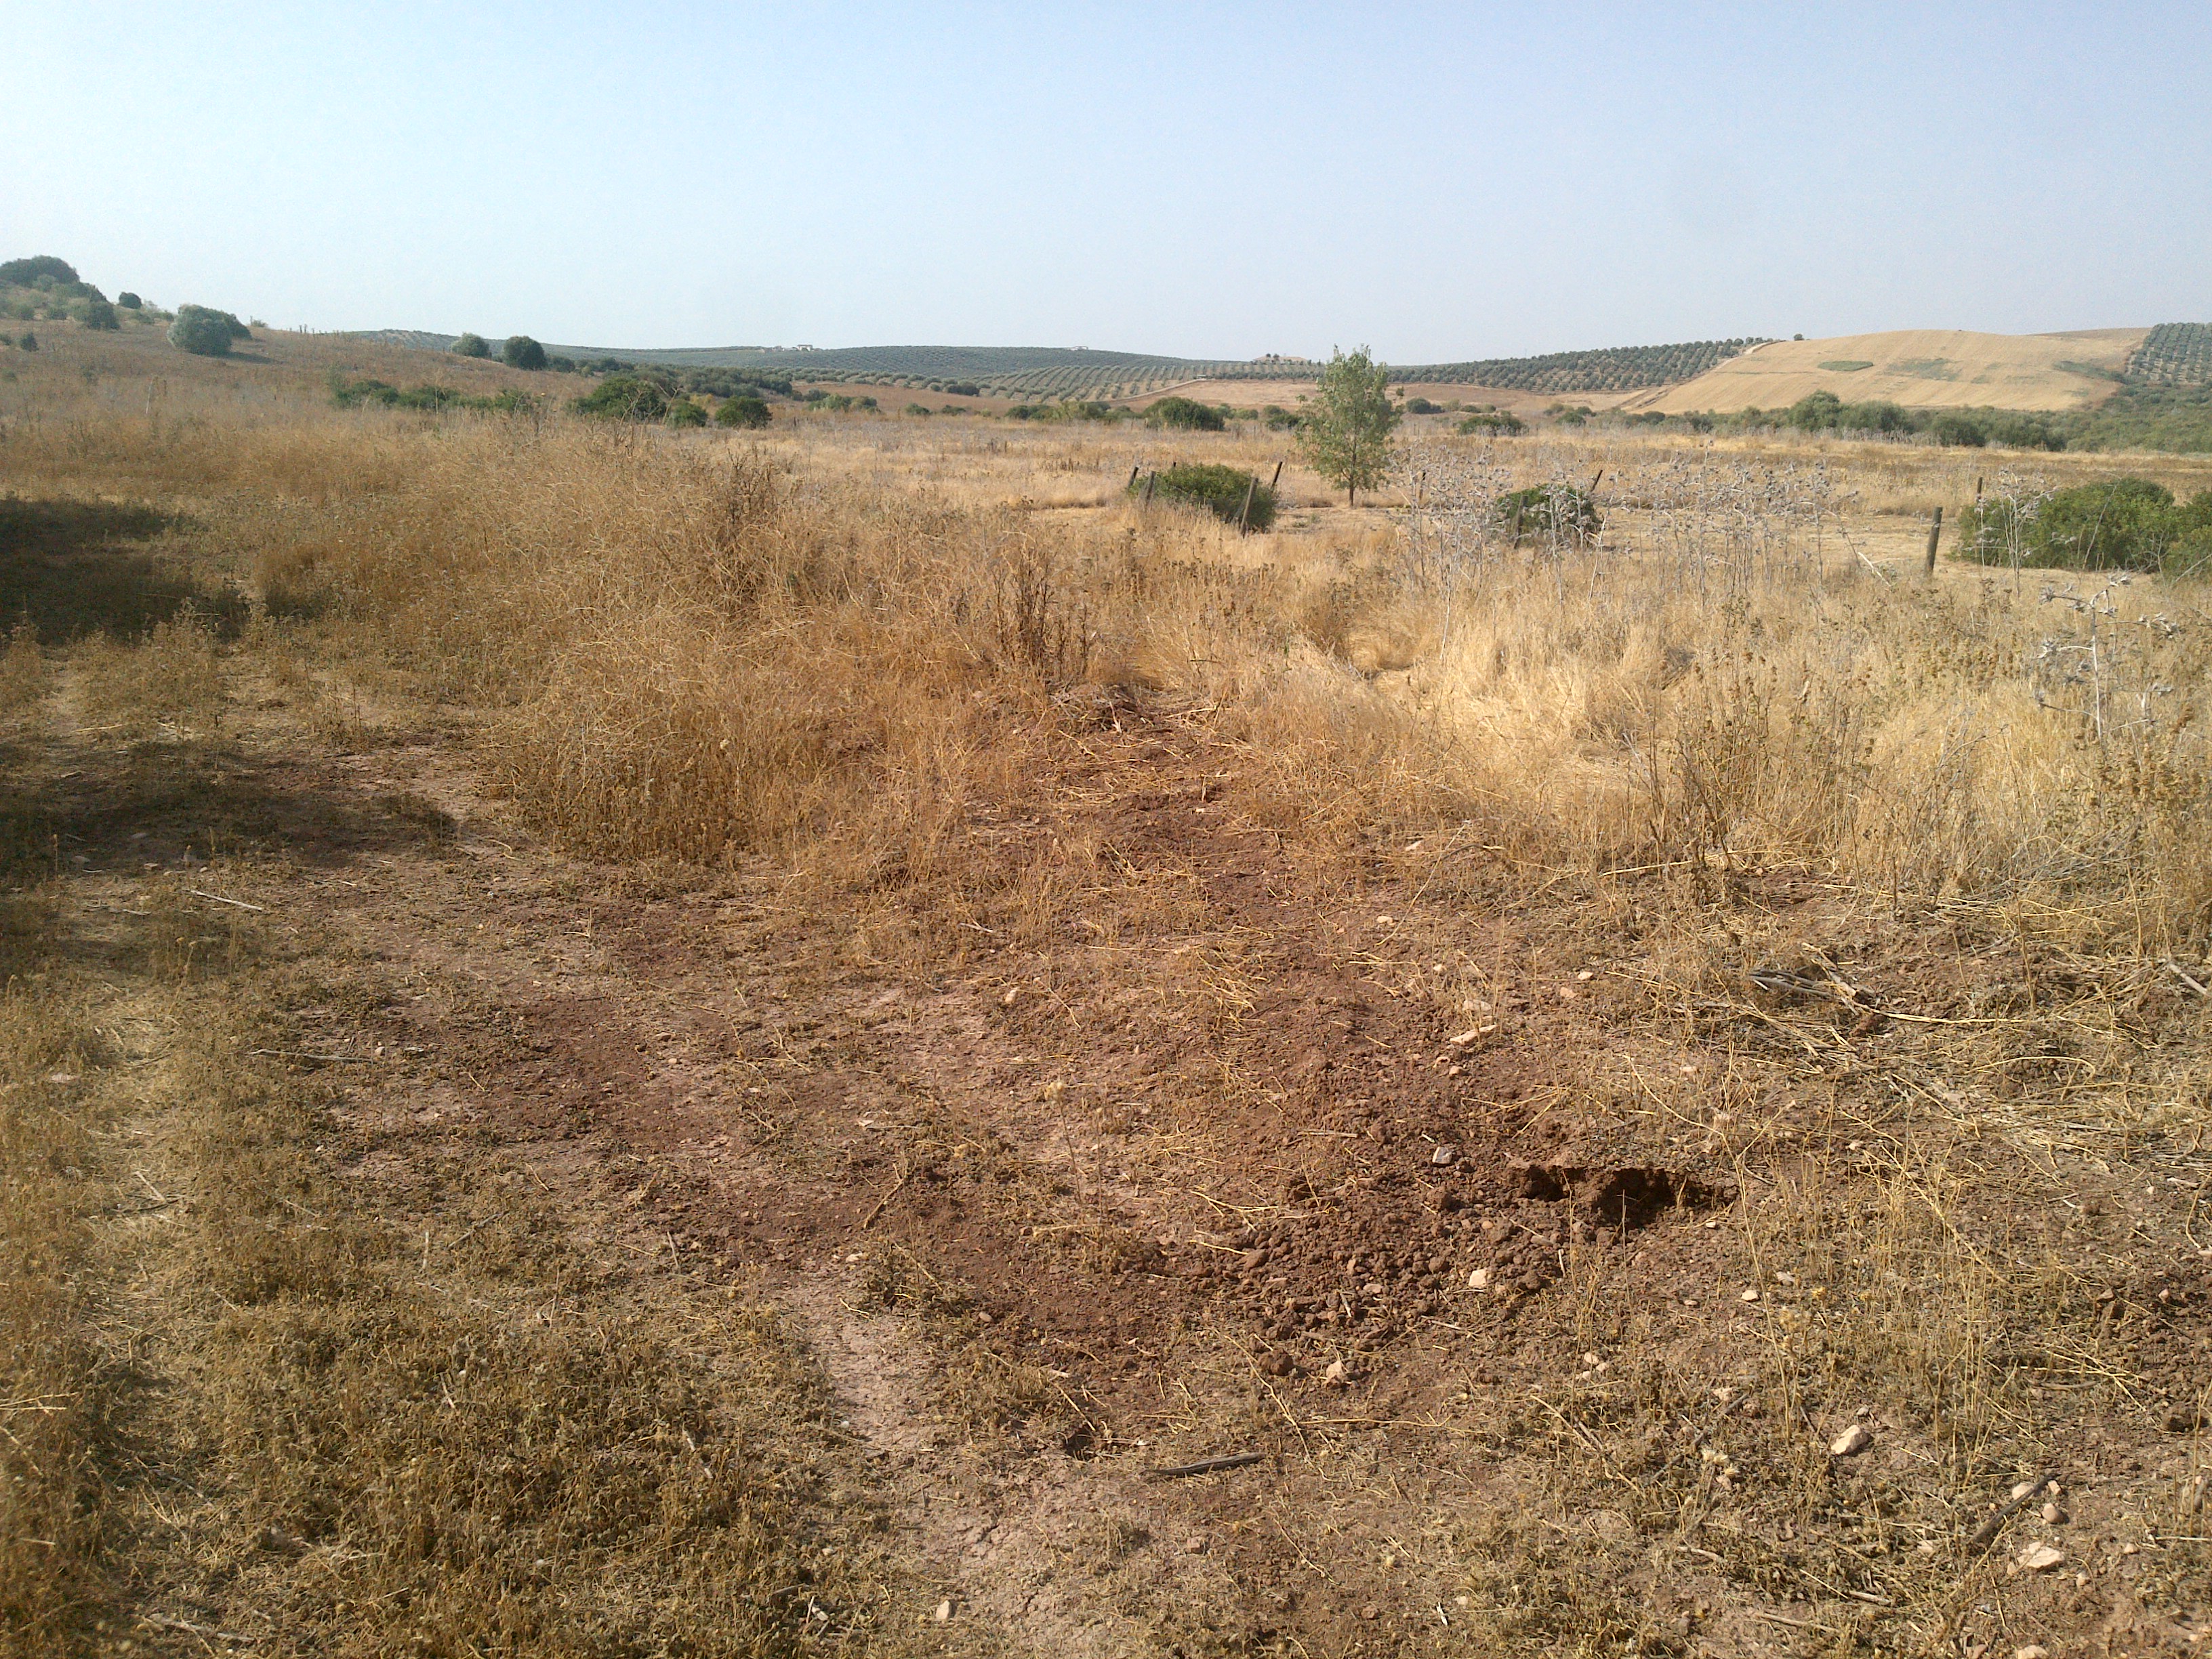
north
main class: Grassland
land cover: Spontaneously vegetated surfaces
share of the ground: 50 - 75 %
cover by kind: herbaceous plants 70 %, unconsolidated bare surface 30 %
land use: Fallow land
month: July
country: ES
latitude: 37.4254
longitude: -4.8218
